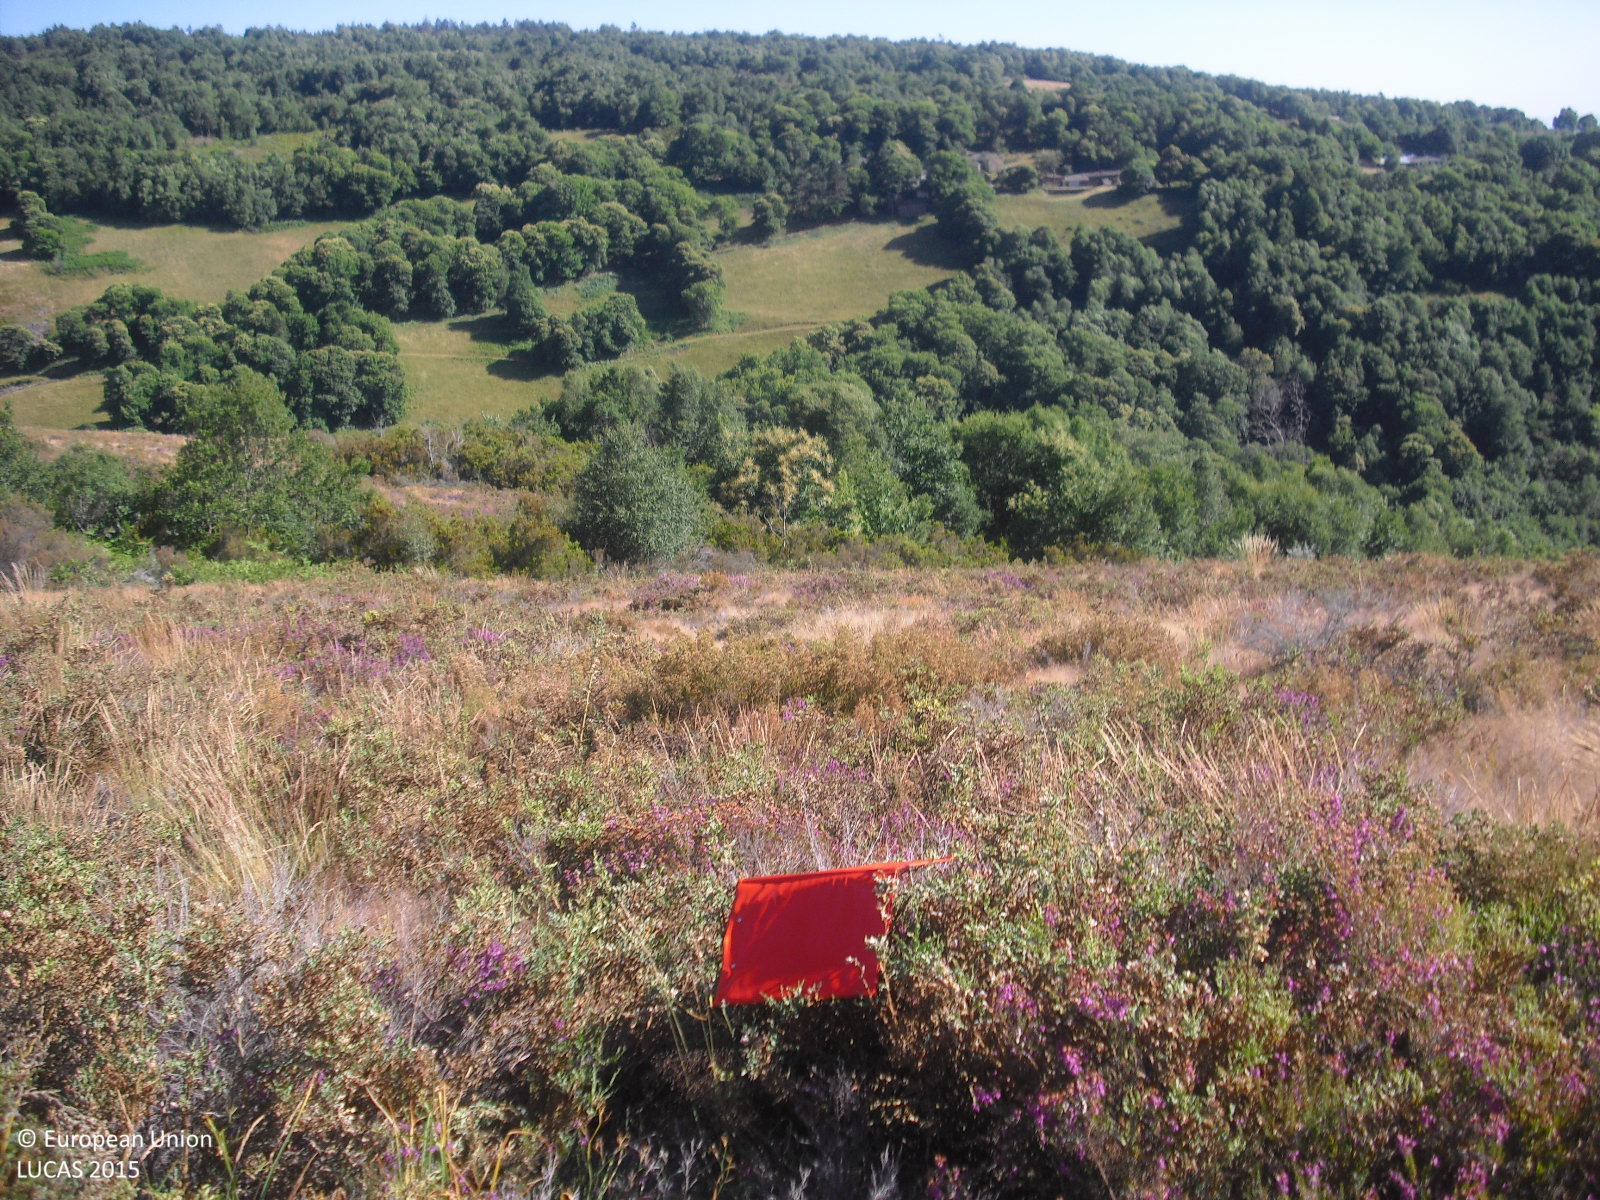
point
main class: Shrubland
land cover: Shrubland without tree cover
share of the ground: > 75 %
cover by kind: shrubs 70 %, herbaceous plants 20 %, consolidated bare surface 5 %, unconsolidated bare surface 5 %
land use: Semi-natural and natural areas not in use
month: July
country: ES
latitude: 42.6229
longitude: -7.3181
